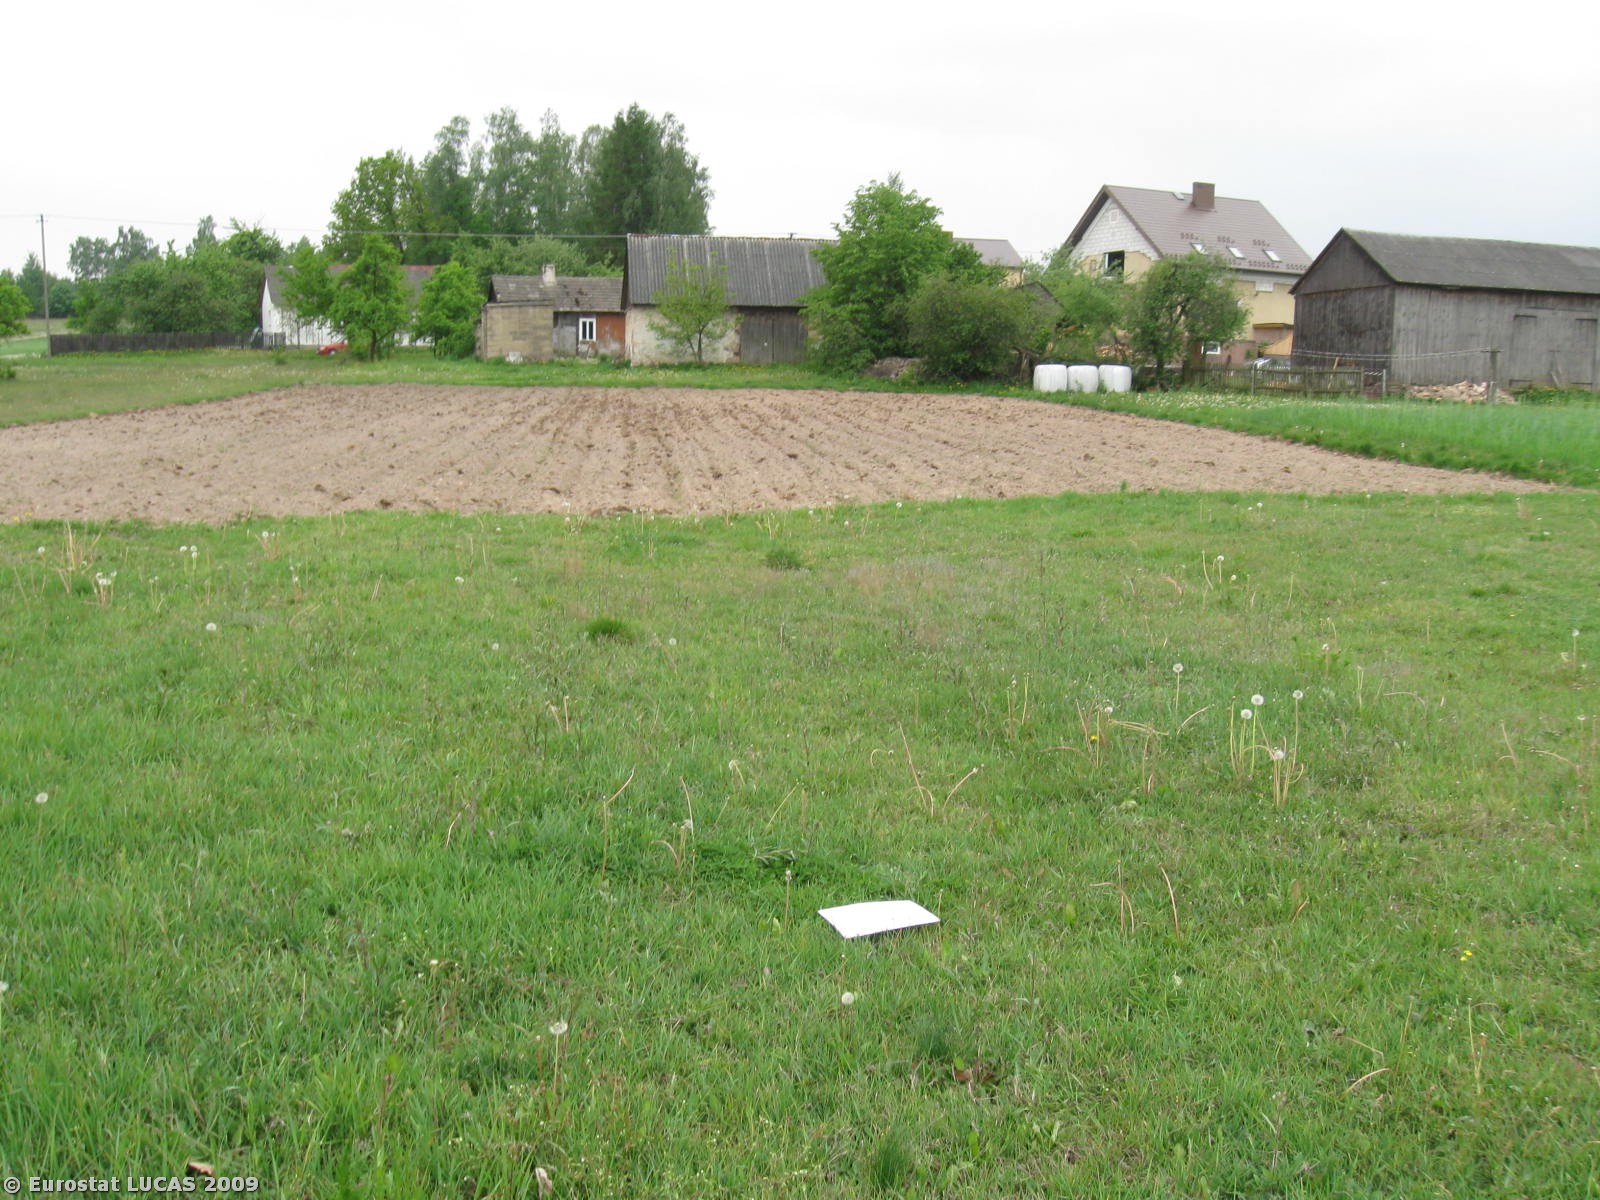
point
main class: Grassland
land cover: Grassland without tree/shrub cover
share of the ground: > 75 %
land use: Agriculture (excluding fallow land and kitchen gardens)
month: May
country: PL
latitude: 51.0103
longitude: 20.4278
